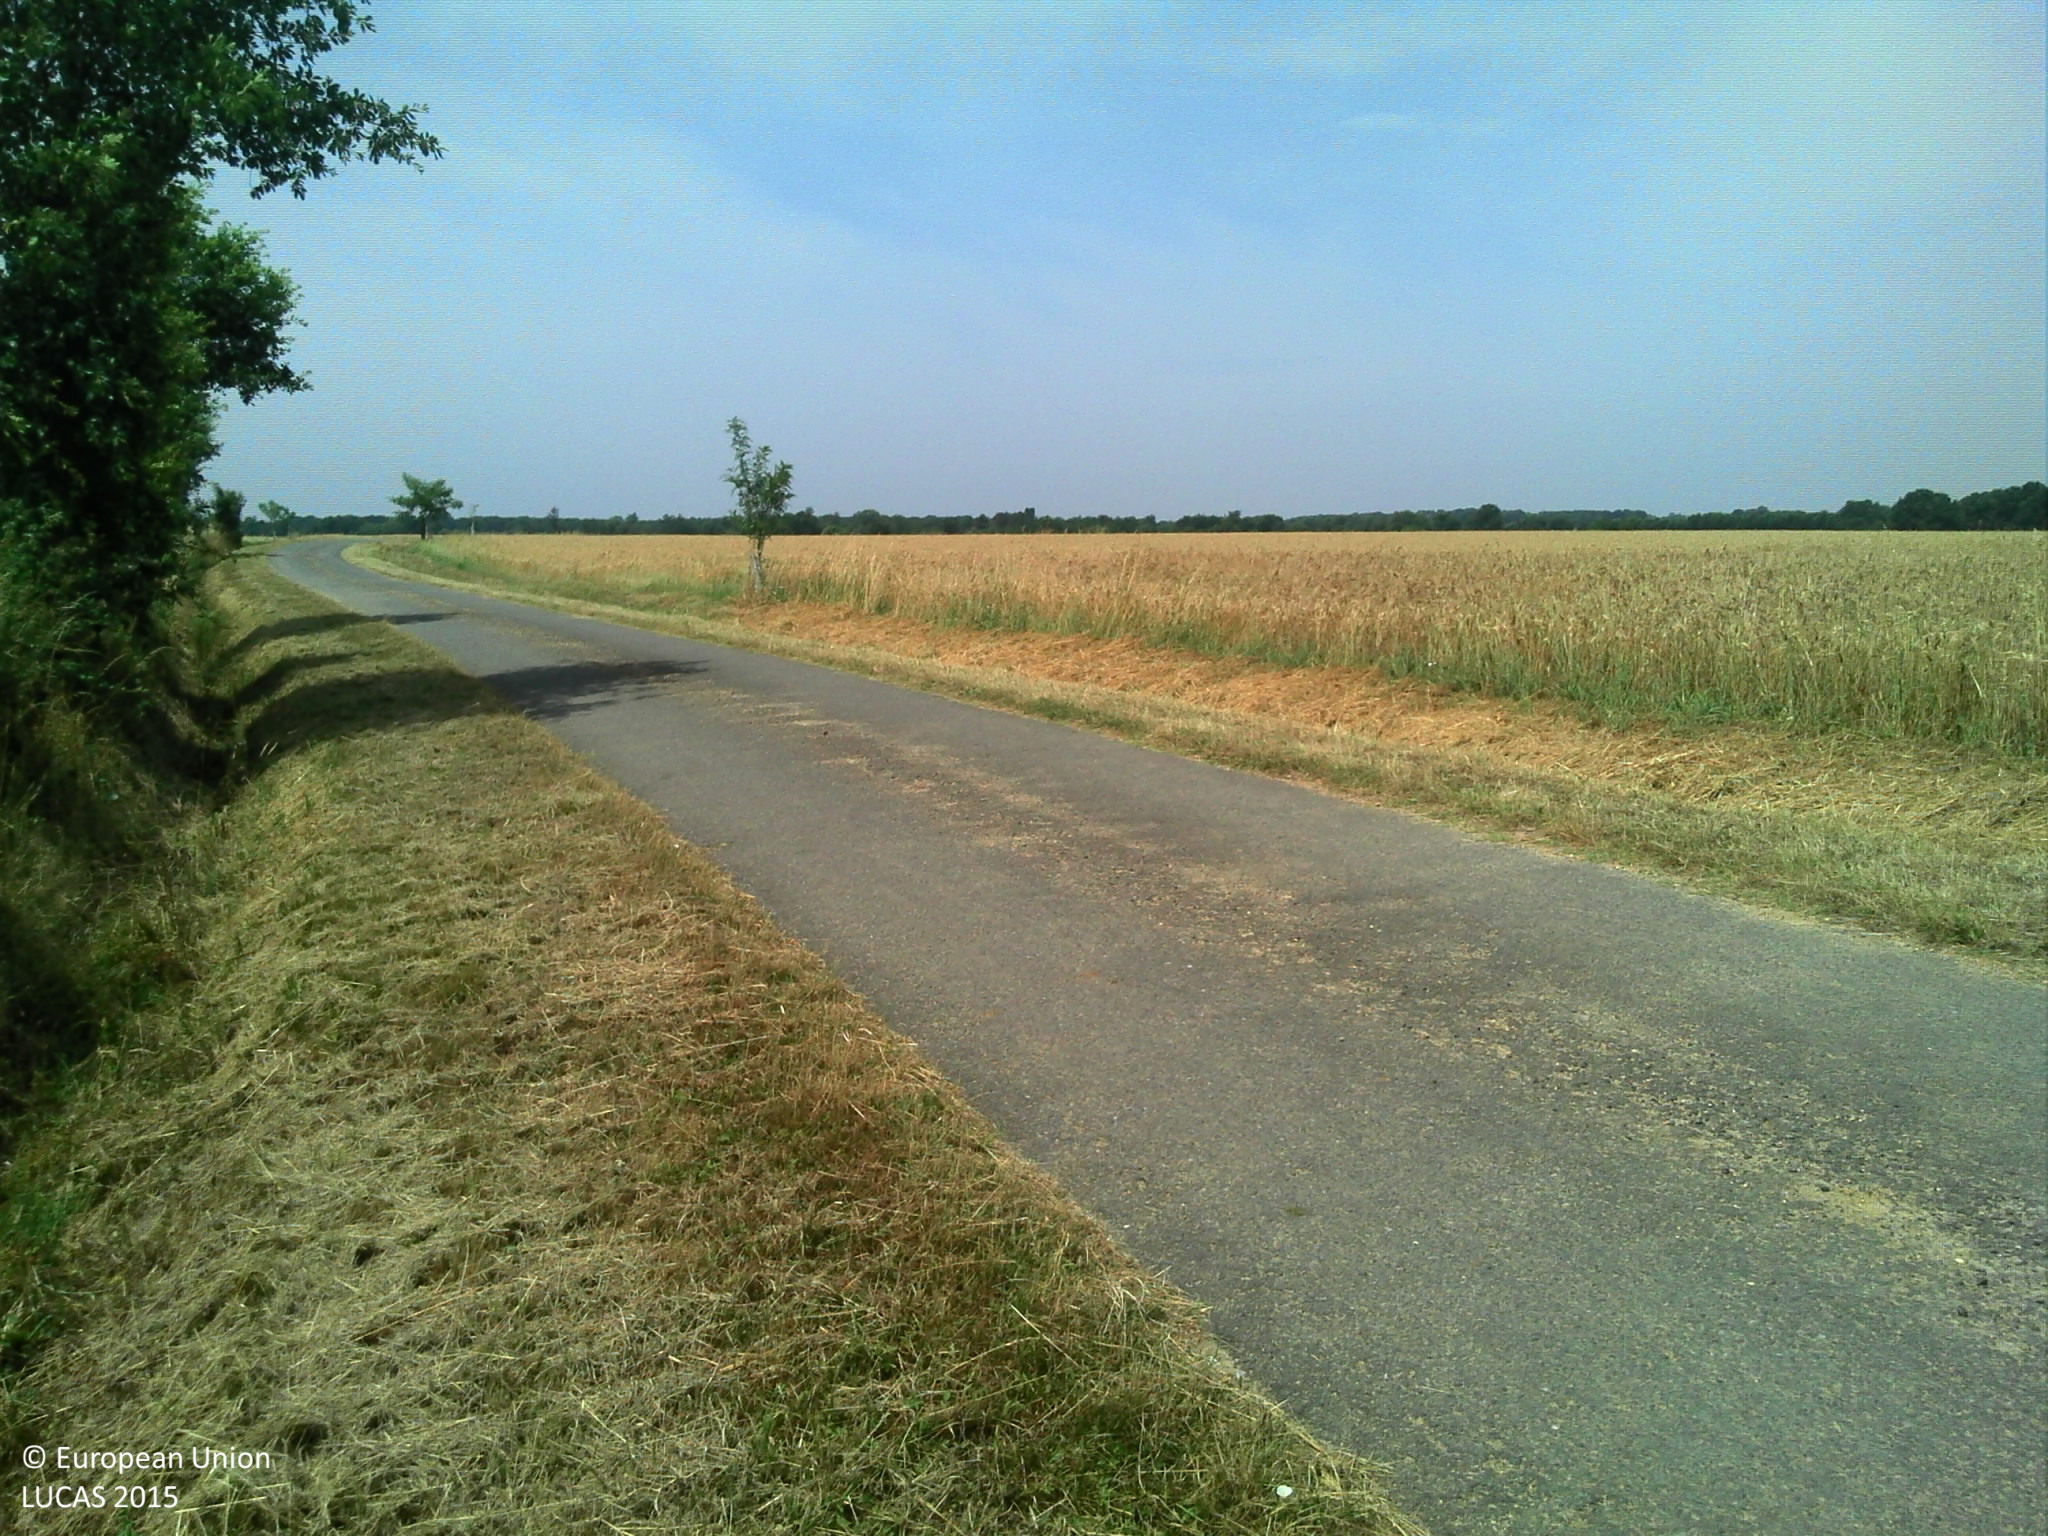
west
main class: Cropland
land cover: Common wheat
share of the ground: > 75 %
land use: Agriculture (excluding fallow land and kitchen gardens)
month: July
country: FR
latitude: 46.4594
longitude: 0.5694
